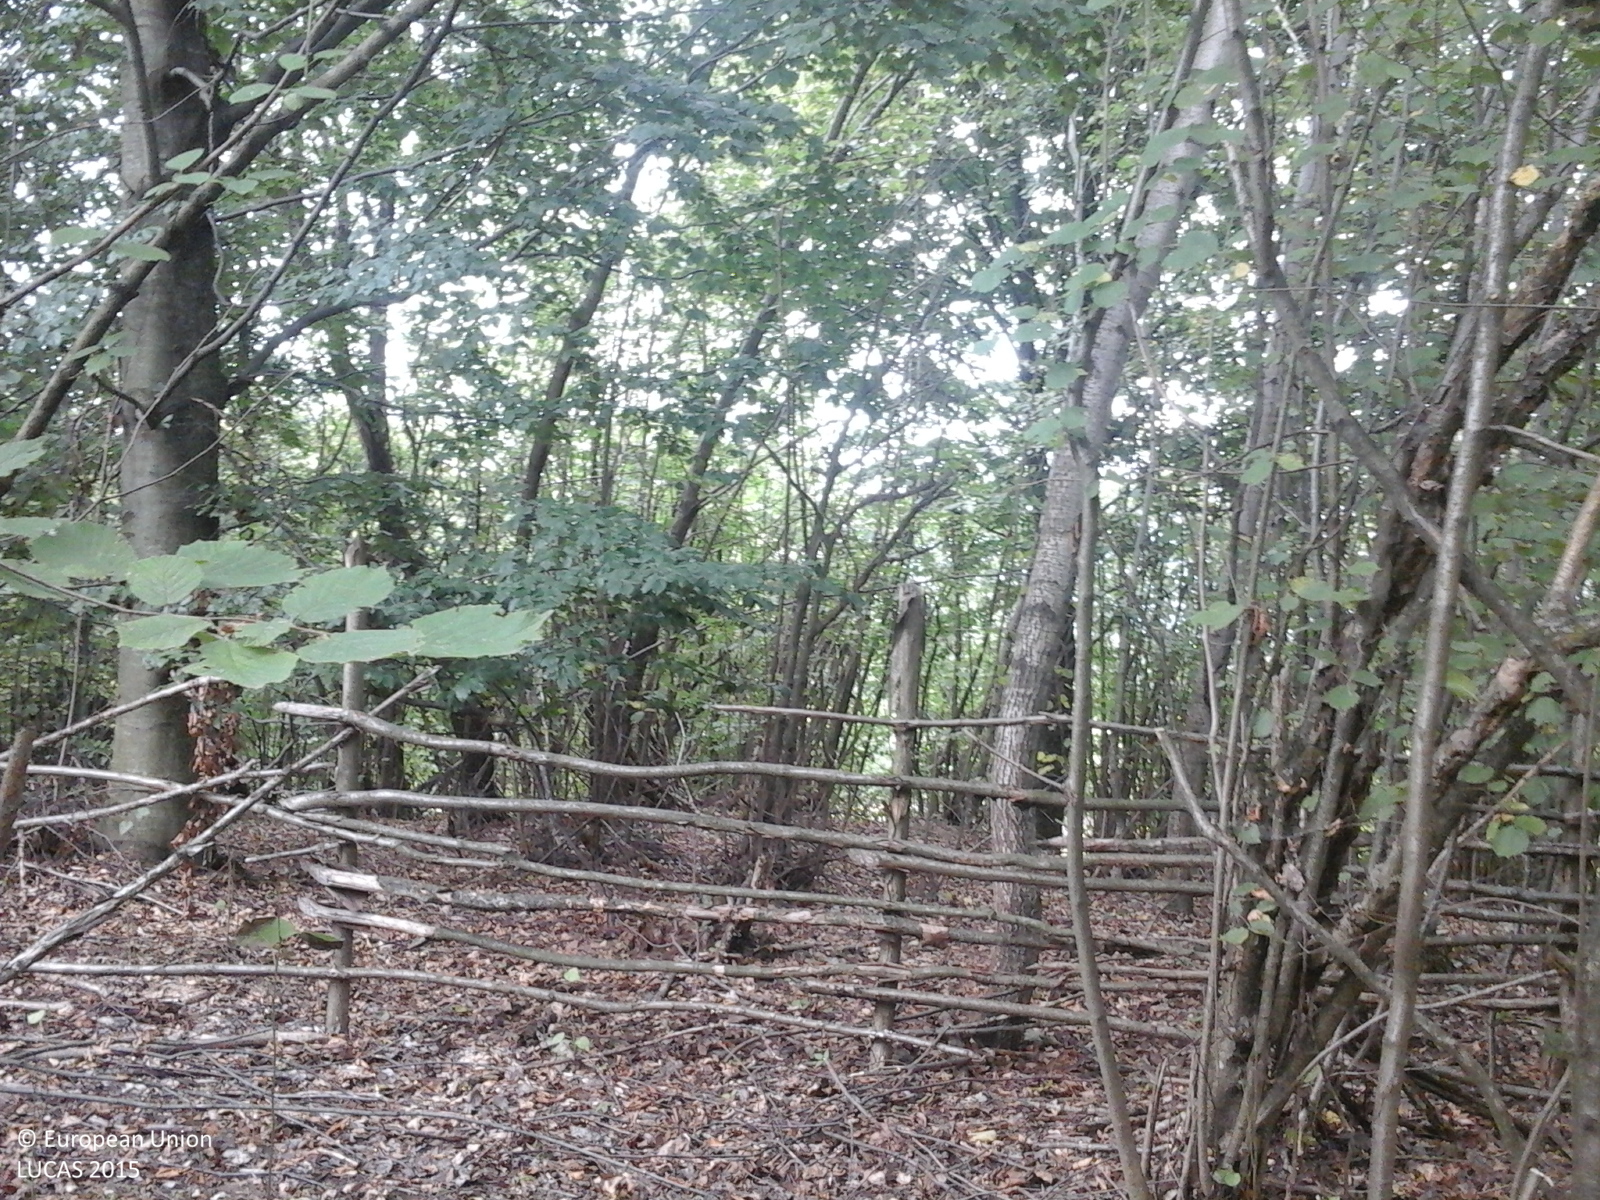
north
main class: Woodland
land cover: Broadleaved woodland
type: non-riverine alder, birch or aspen forest
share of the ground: > 75 %
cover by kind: broadleaved forest trees 100 %
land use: Forestry
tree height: > 5 m
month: September
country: RO
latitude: 47.9509
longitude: 23.6703
